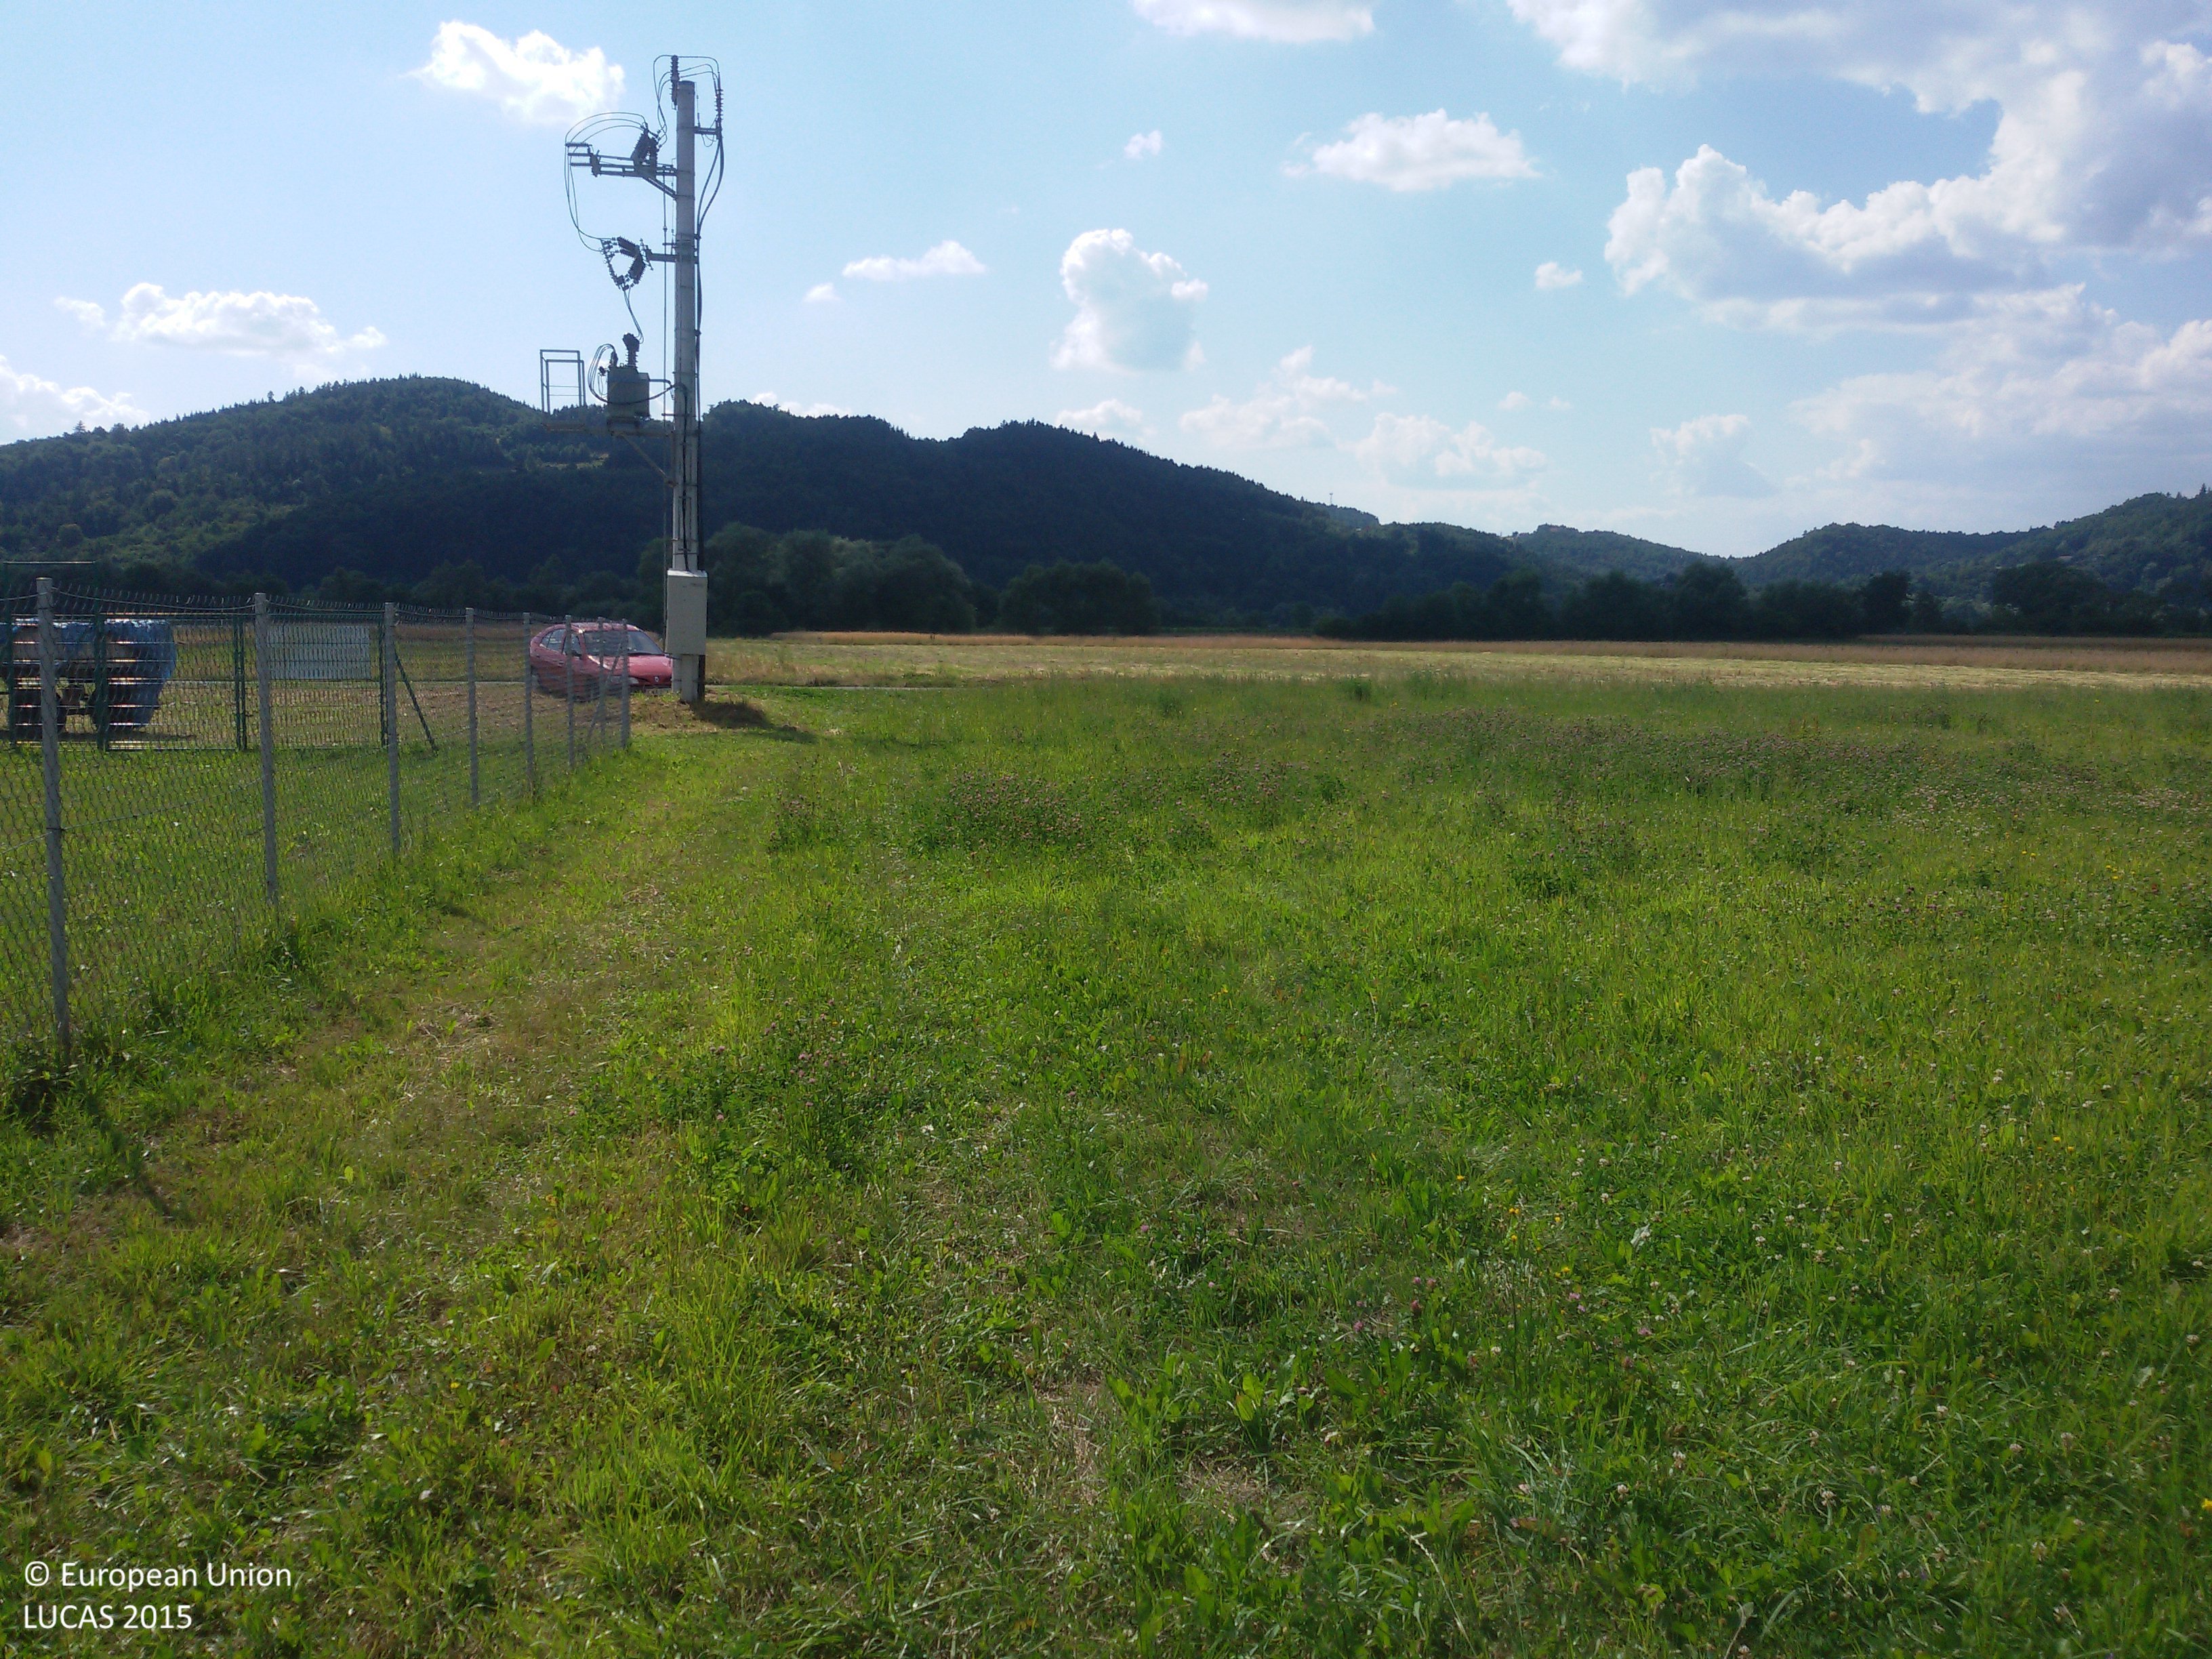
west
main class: Grassland
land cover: Grassland without tree/shrub cover
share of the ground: > 75 %
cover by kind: herbaceous plants 100 %
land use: Water supply and treatment
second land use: Agriculture (excluding fallow land and kitchen gardens)
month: July
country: PL
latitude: 49.7913
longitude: 20.6658
